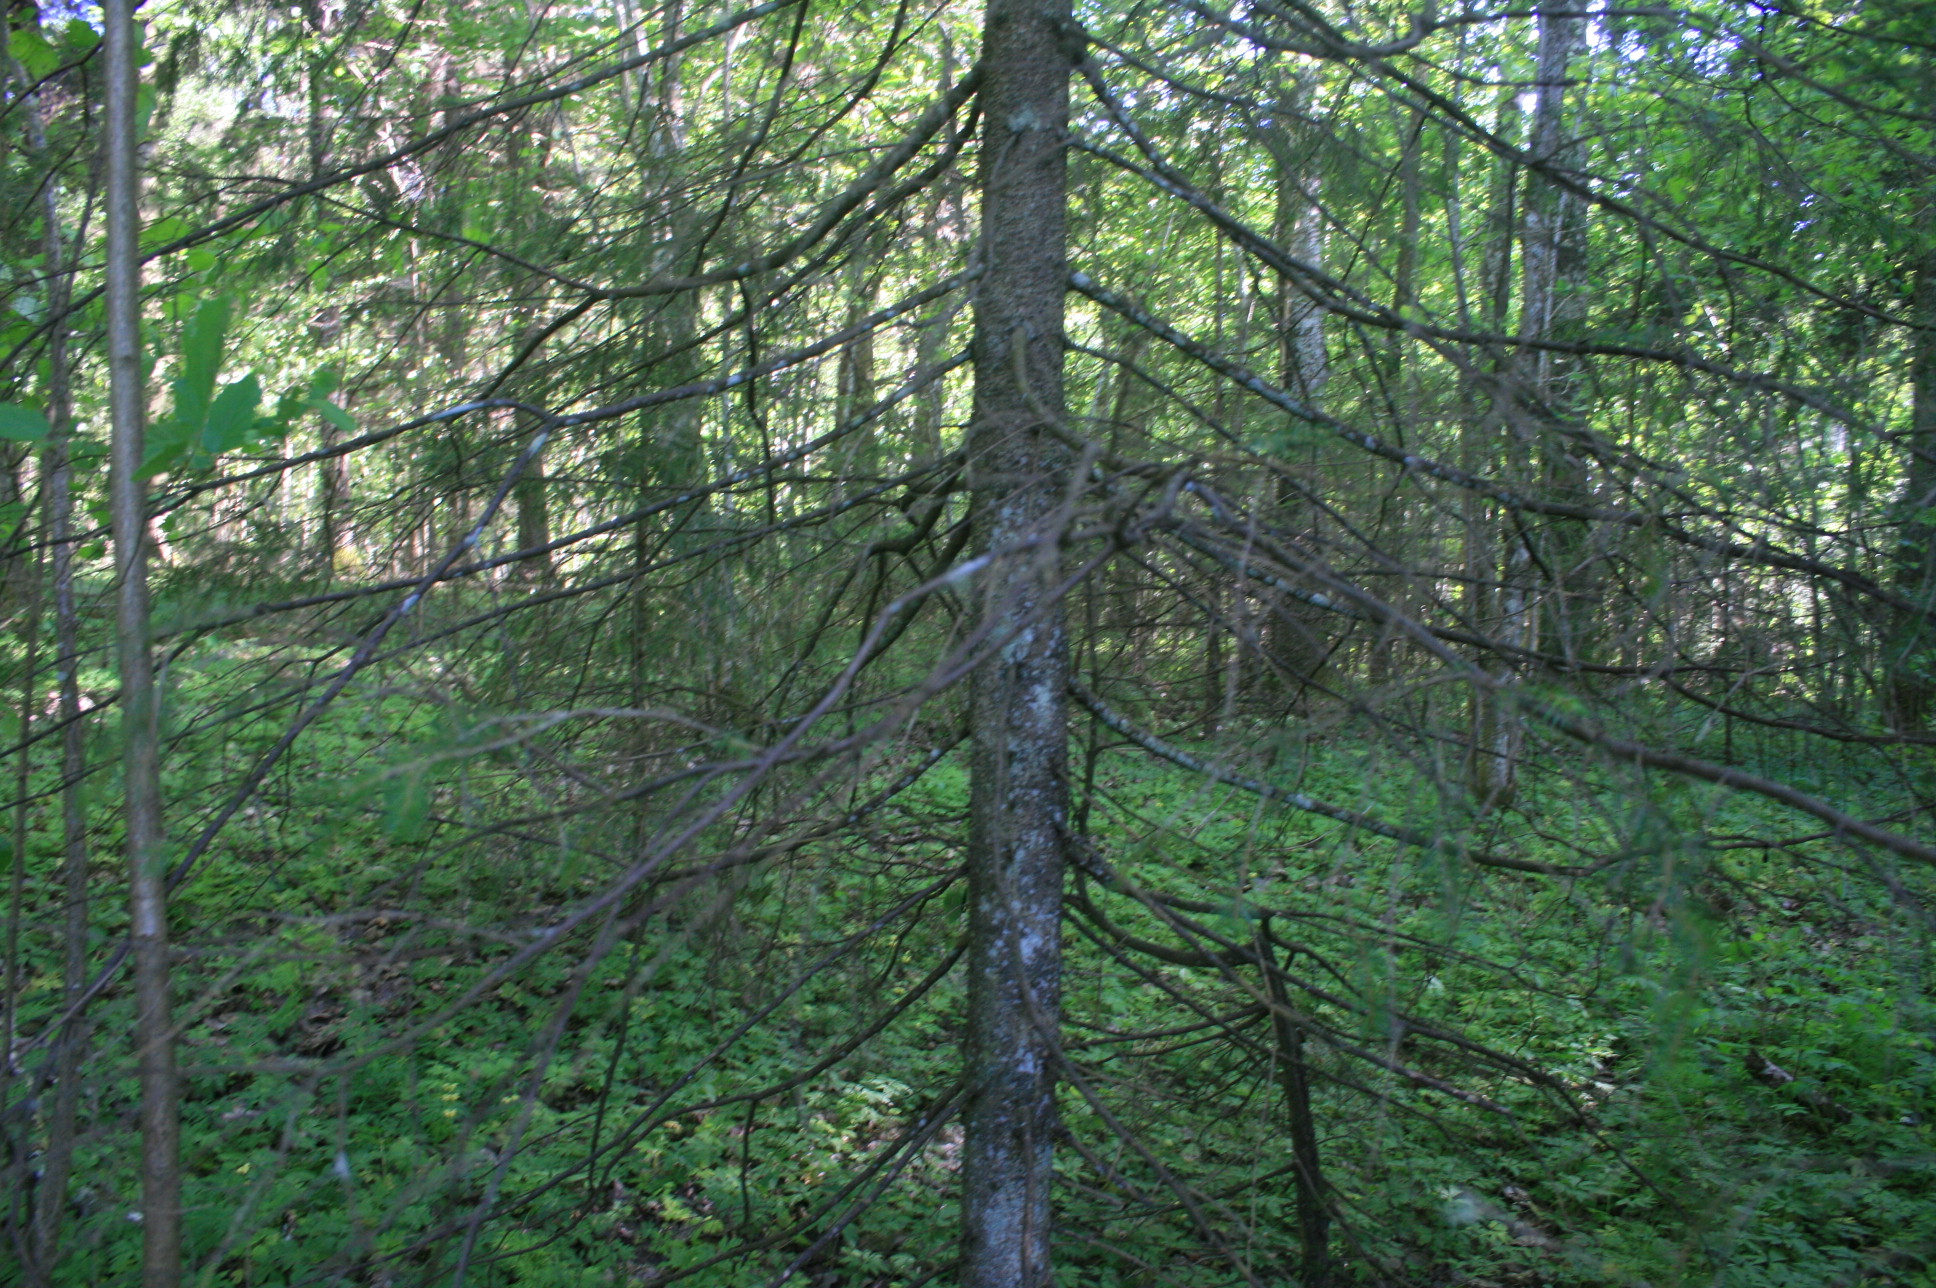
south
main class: Woodland
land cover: Broadleaved woodland
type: non-riverine alder, birch or aspen forest
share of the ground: > 75 %
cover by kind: broadleaved forest trees 95 %, herbaceous plants 5 %
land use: Forestry
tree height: > 5 m
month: June
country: LT
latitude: 56.0192
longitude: 22.0357
